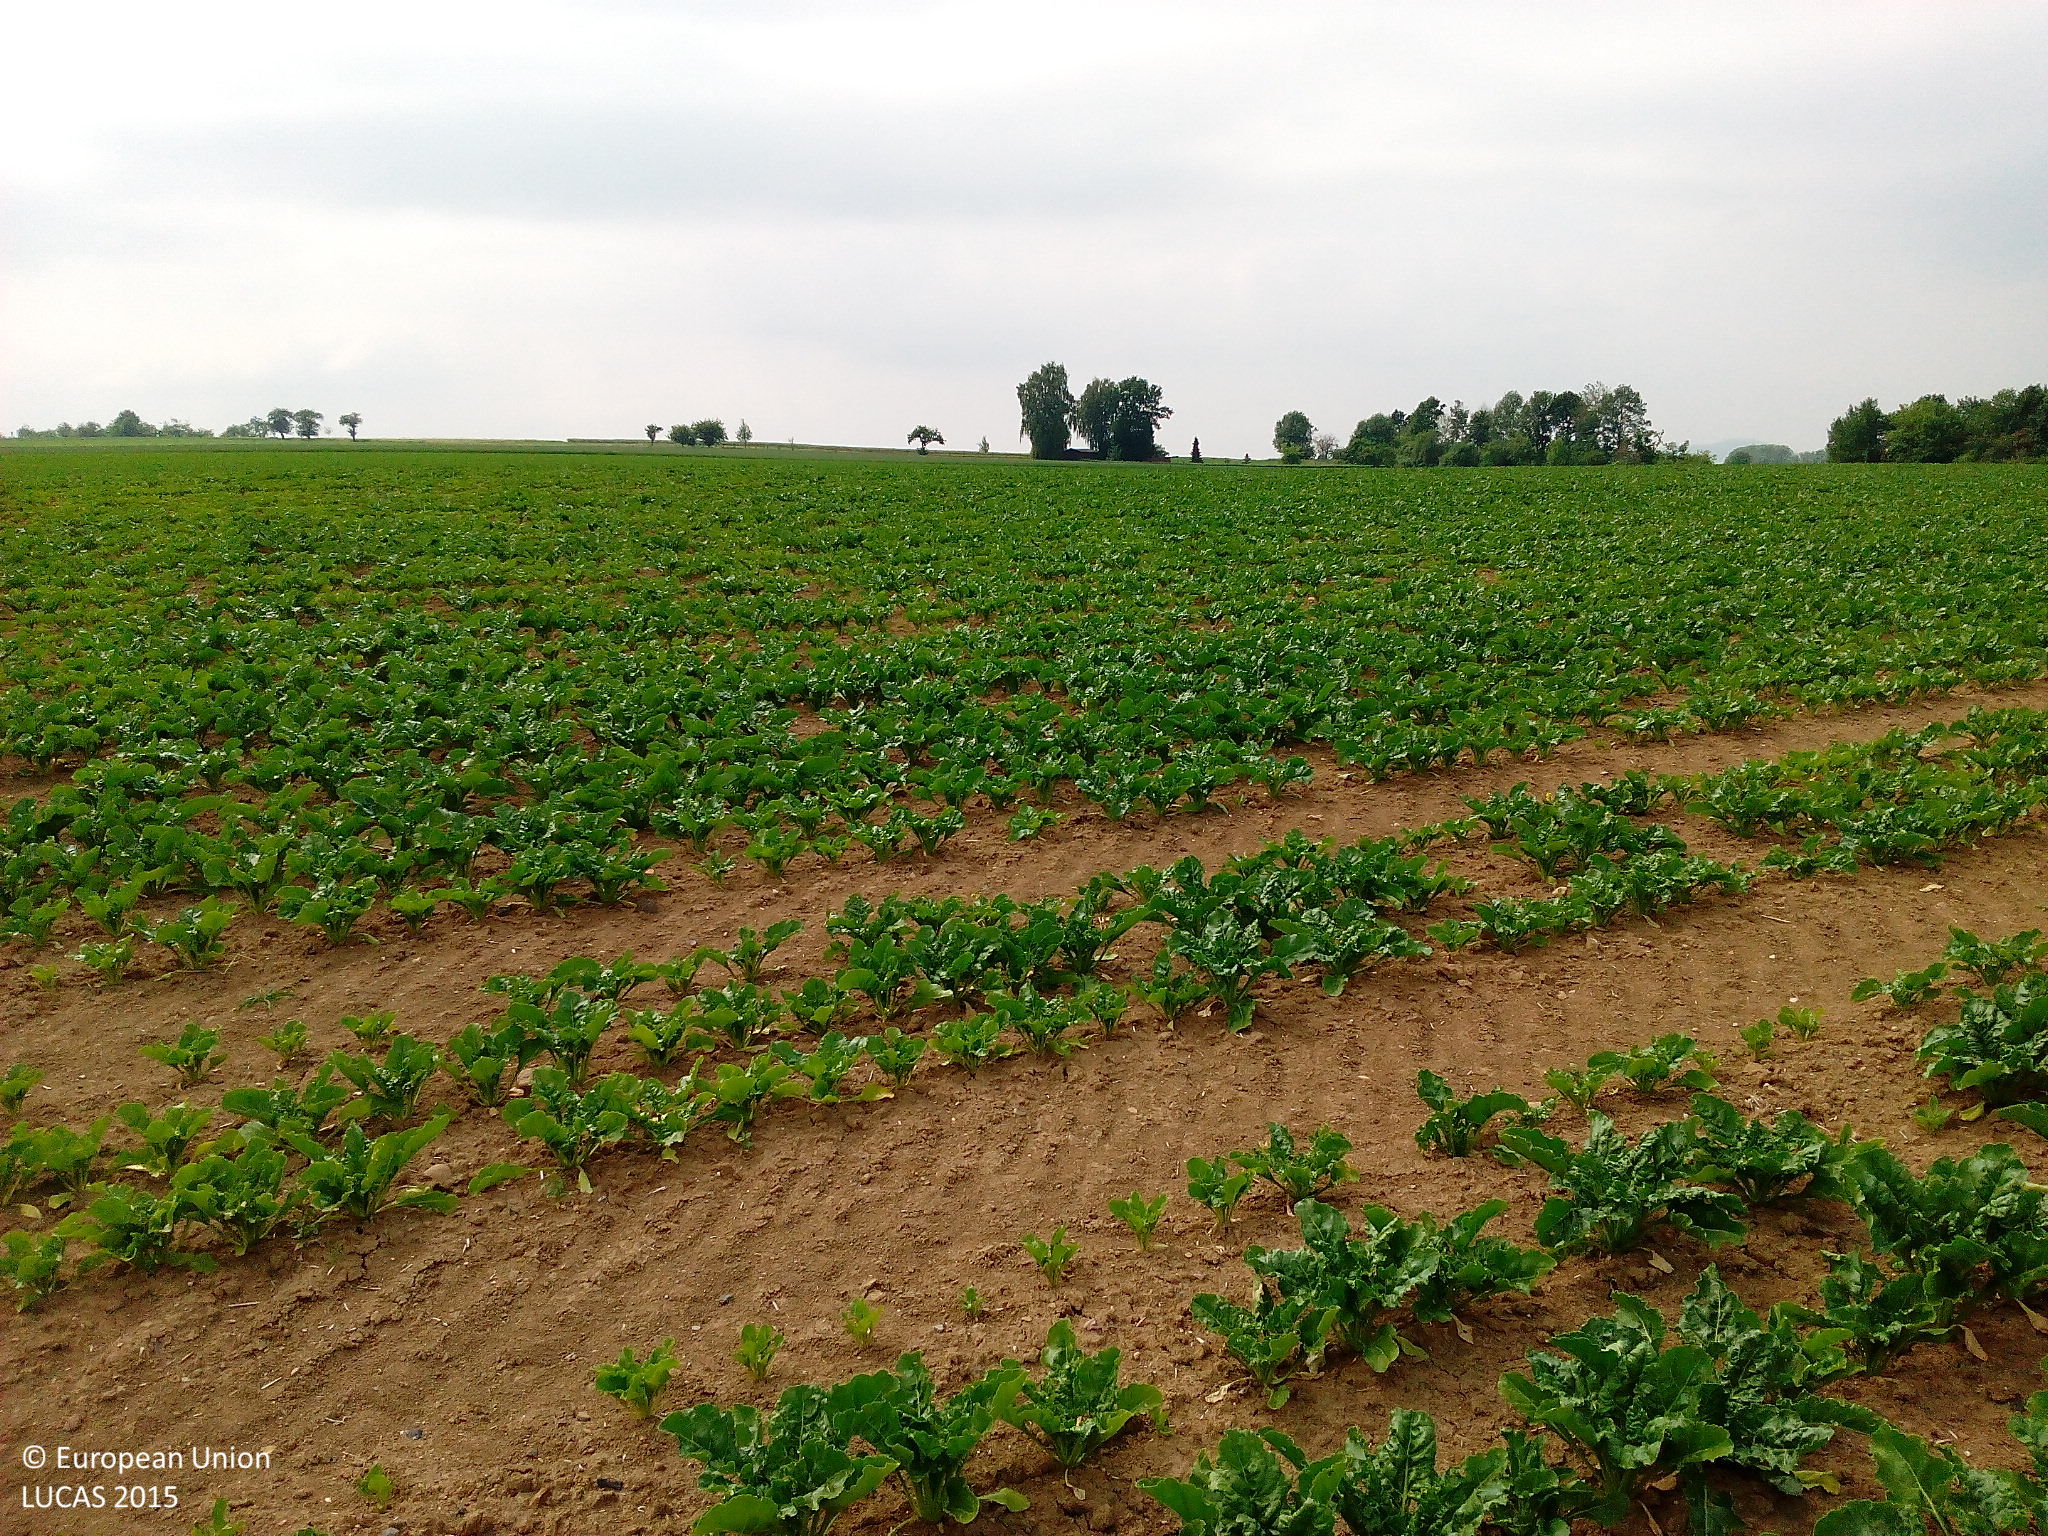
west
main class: Cropland
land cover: Sugar beet
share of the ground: 25 - 50 %
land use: Agriculture (excluding fallow land and kitchen gardens)
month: June
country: DE
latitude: 51.1534
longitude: 9.3568
